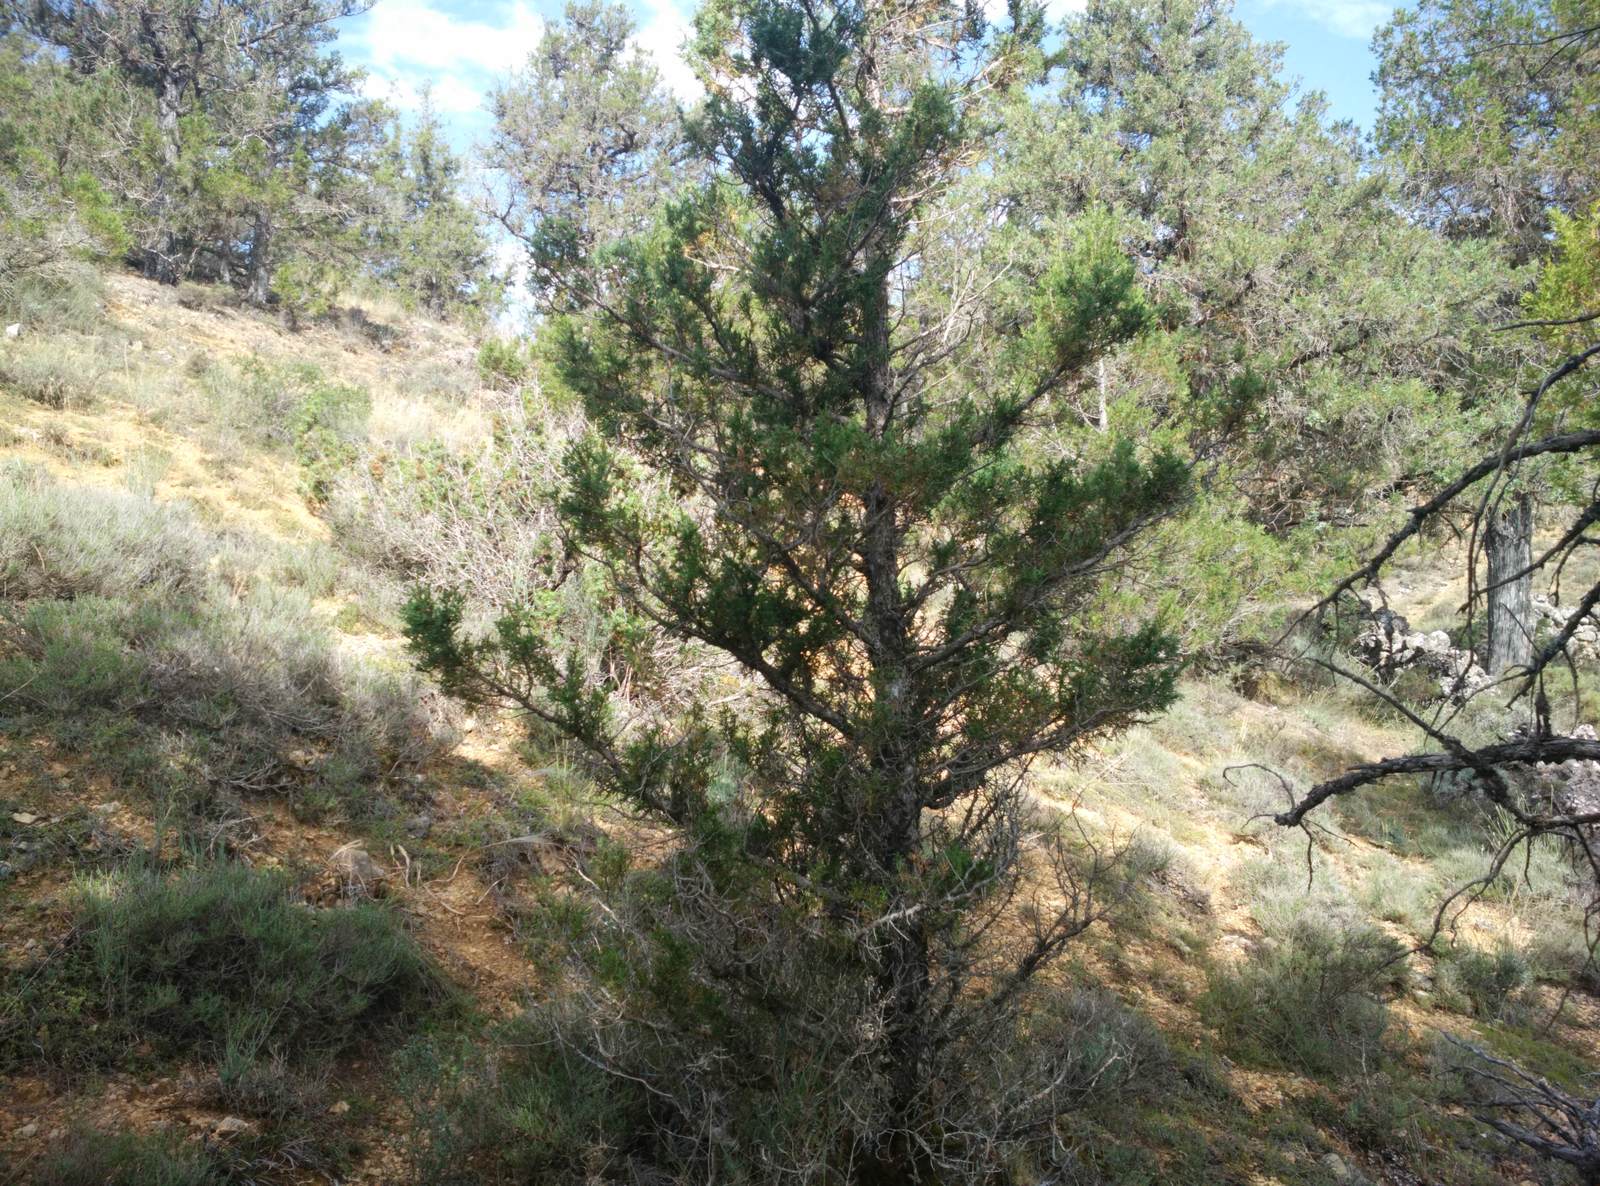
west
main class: Woodland
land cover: Other coniferous woodland
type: coniferous forest of the mediterranean region
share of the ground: 25 - 50 %
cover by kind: herbaceous plants 50 %, coniferous forest trees 30 %, shrubs 10 %, unconsolidated bare surface 10 %
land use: Semi-natural and natural areas not in use
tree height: > 5 m
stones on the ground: 10 - 25 %
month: July
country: ES
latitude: 40.8827
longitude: -1.9740
